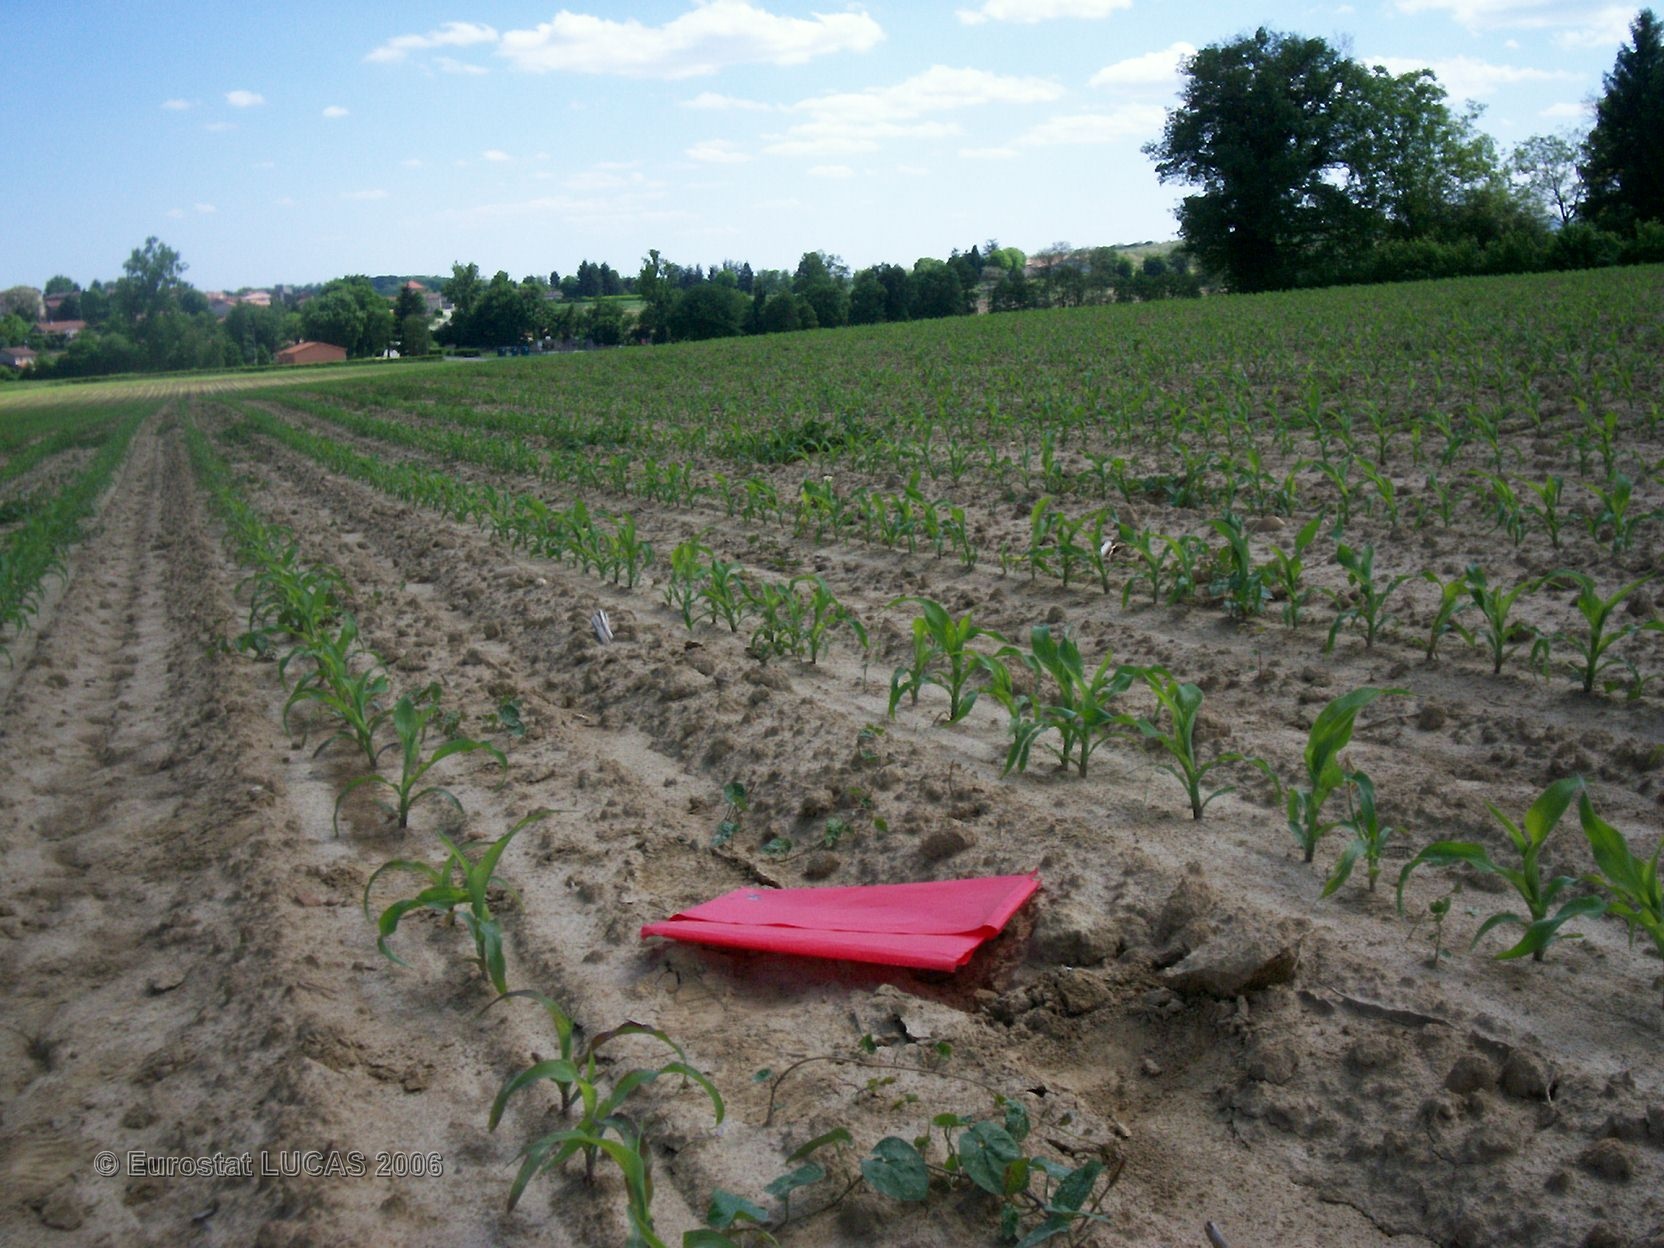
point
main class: Cropland
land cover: Maize
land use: Agriculture (excluding fallow land and kitchen gardens)
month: May
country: FR
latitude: 45.9579
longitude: 4.8808
